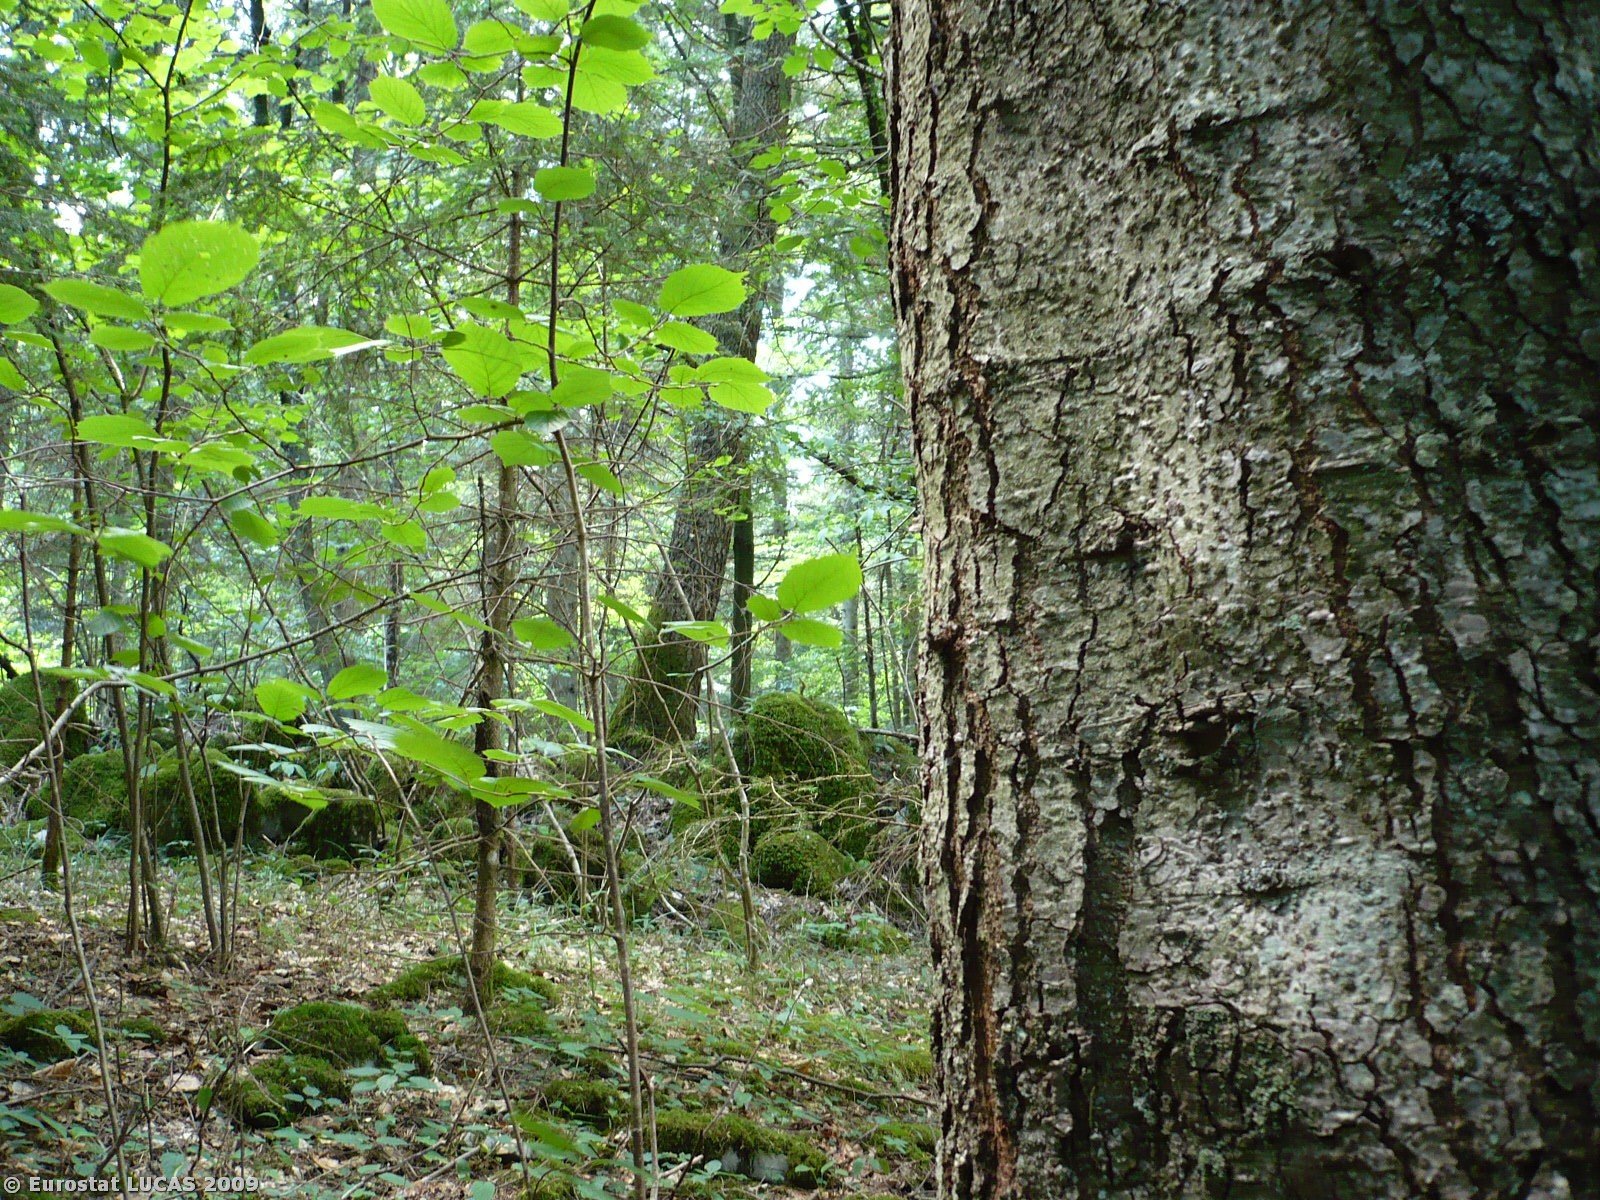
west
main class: Woodland
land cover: Mixed woodland
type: beech forest
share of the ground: > 75 %
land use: Forestry
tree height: > 5 m
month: August
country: SI
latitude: 45.8484
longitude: 14.3357
